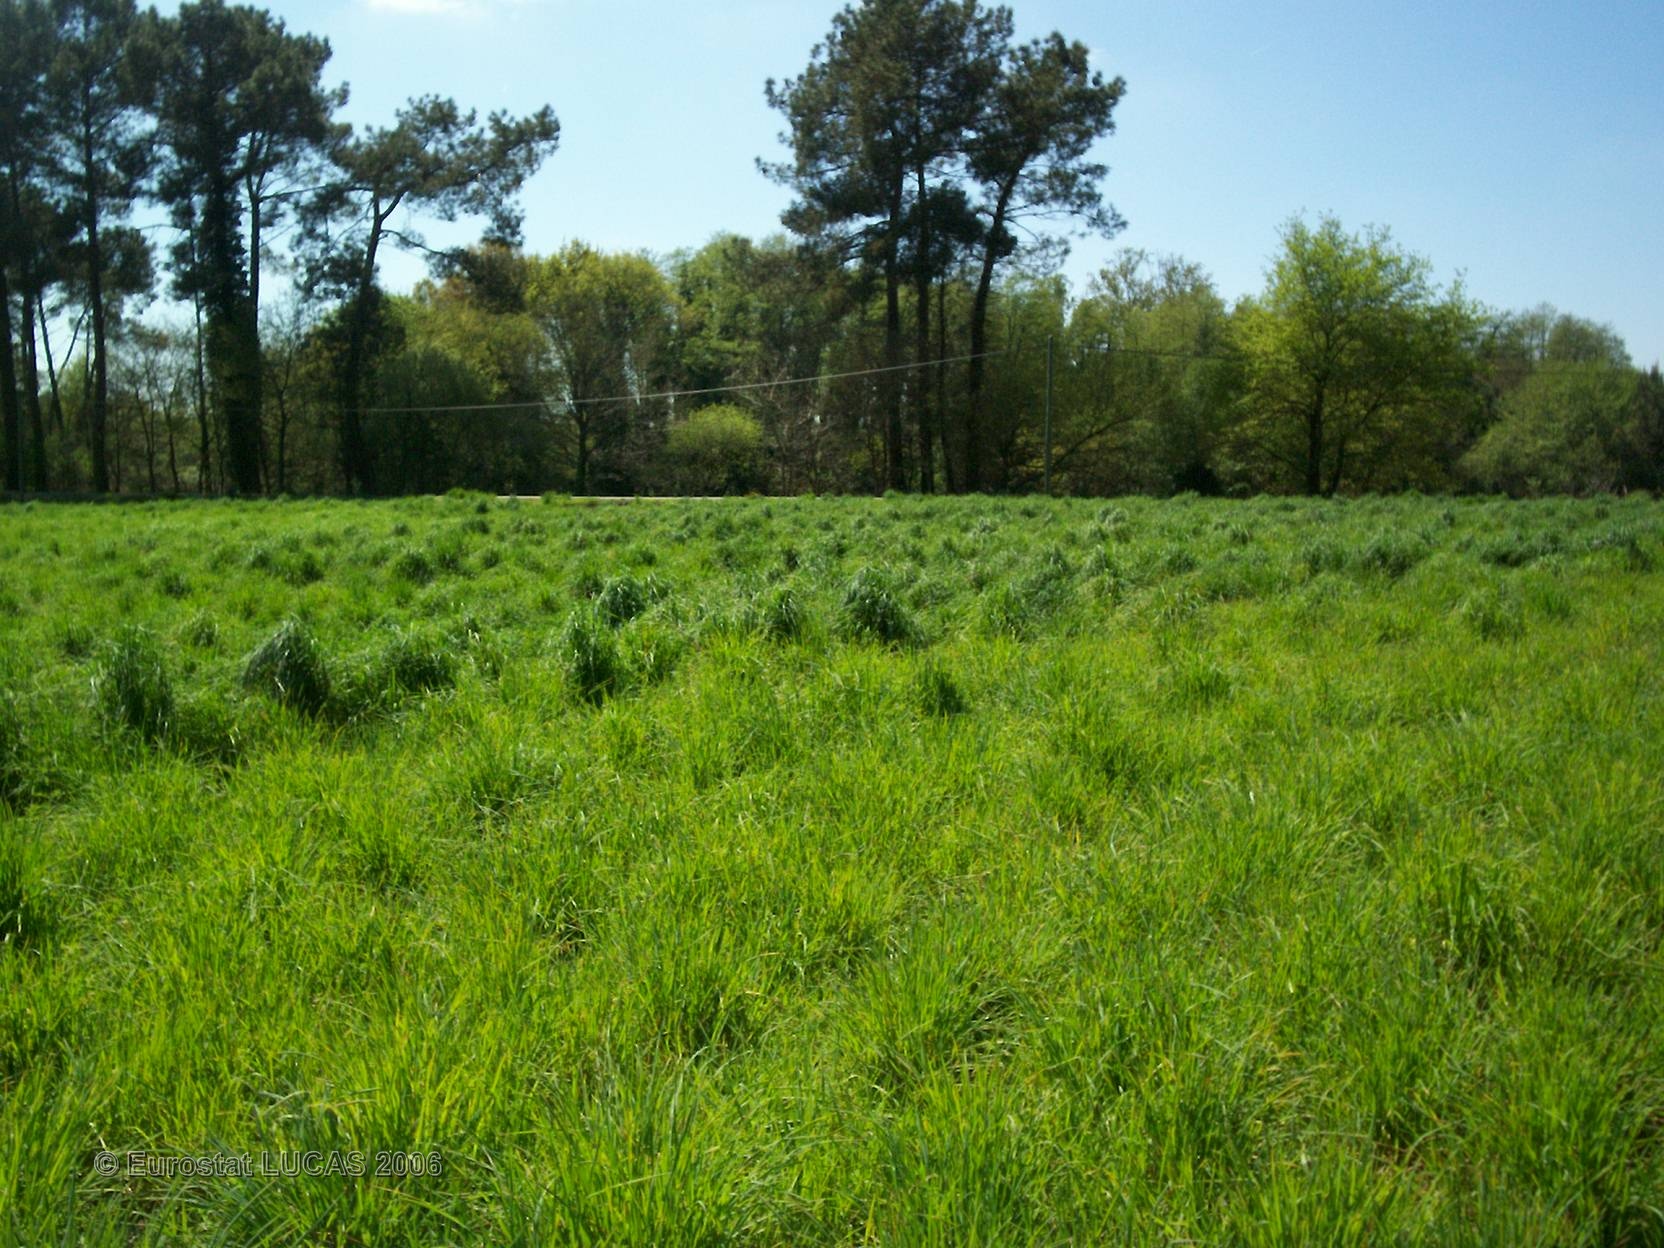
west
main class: Grassland
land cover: Grassland without tree/shrub cover
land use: Agriculture (excluding fallow land and kitchen gardens)
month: April
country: FR
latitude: 43.8121
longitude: -0.7170
